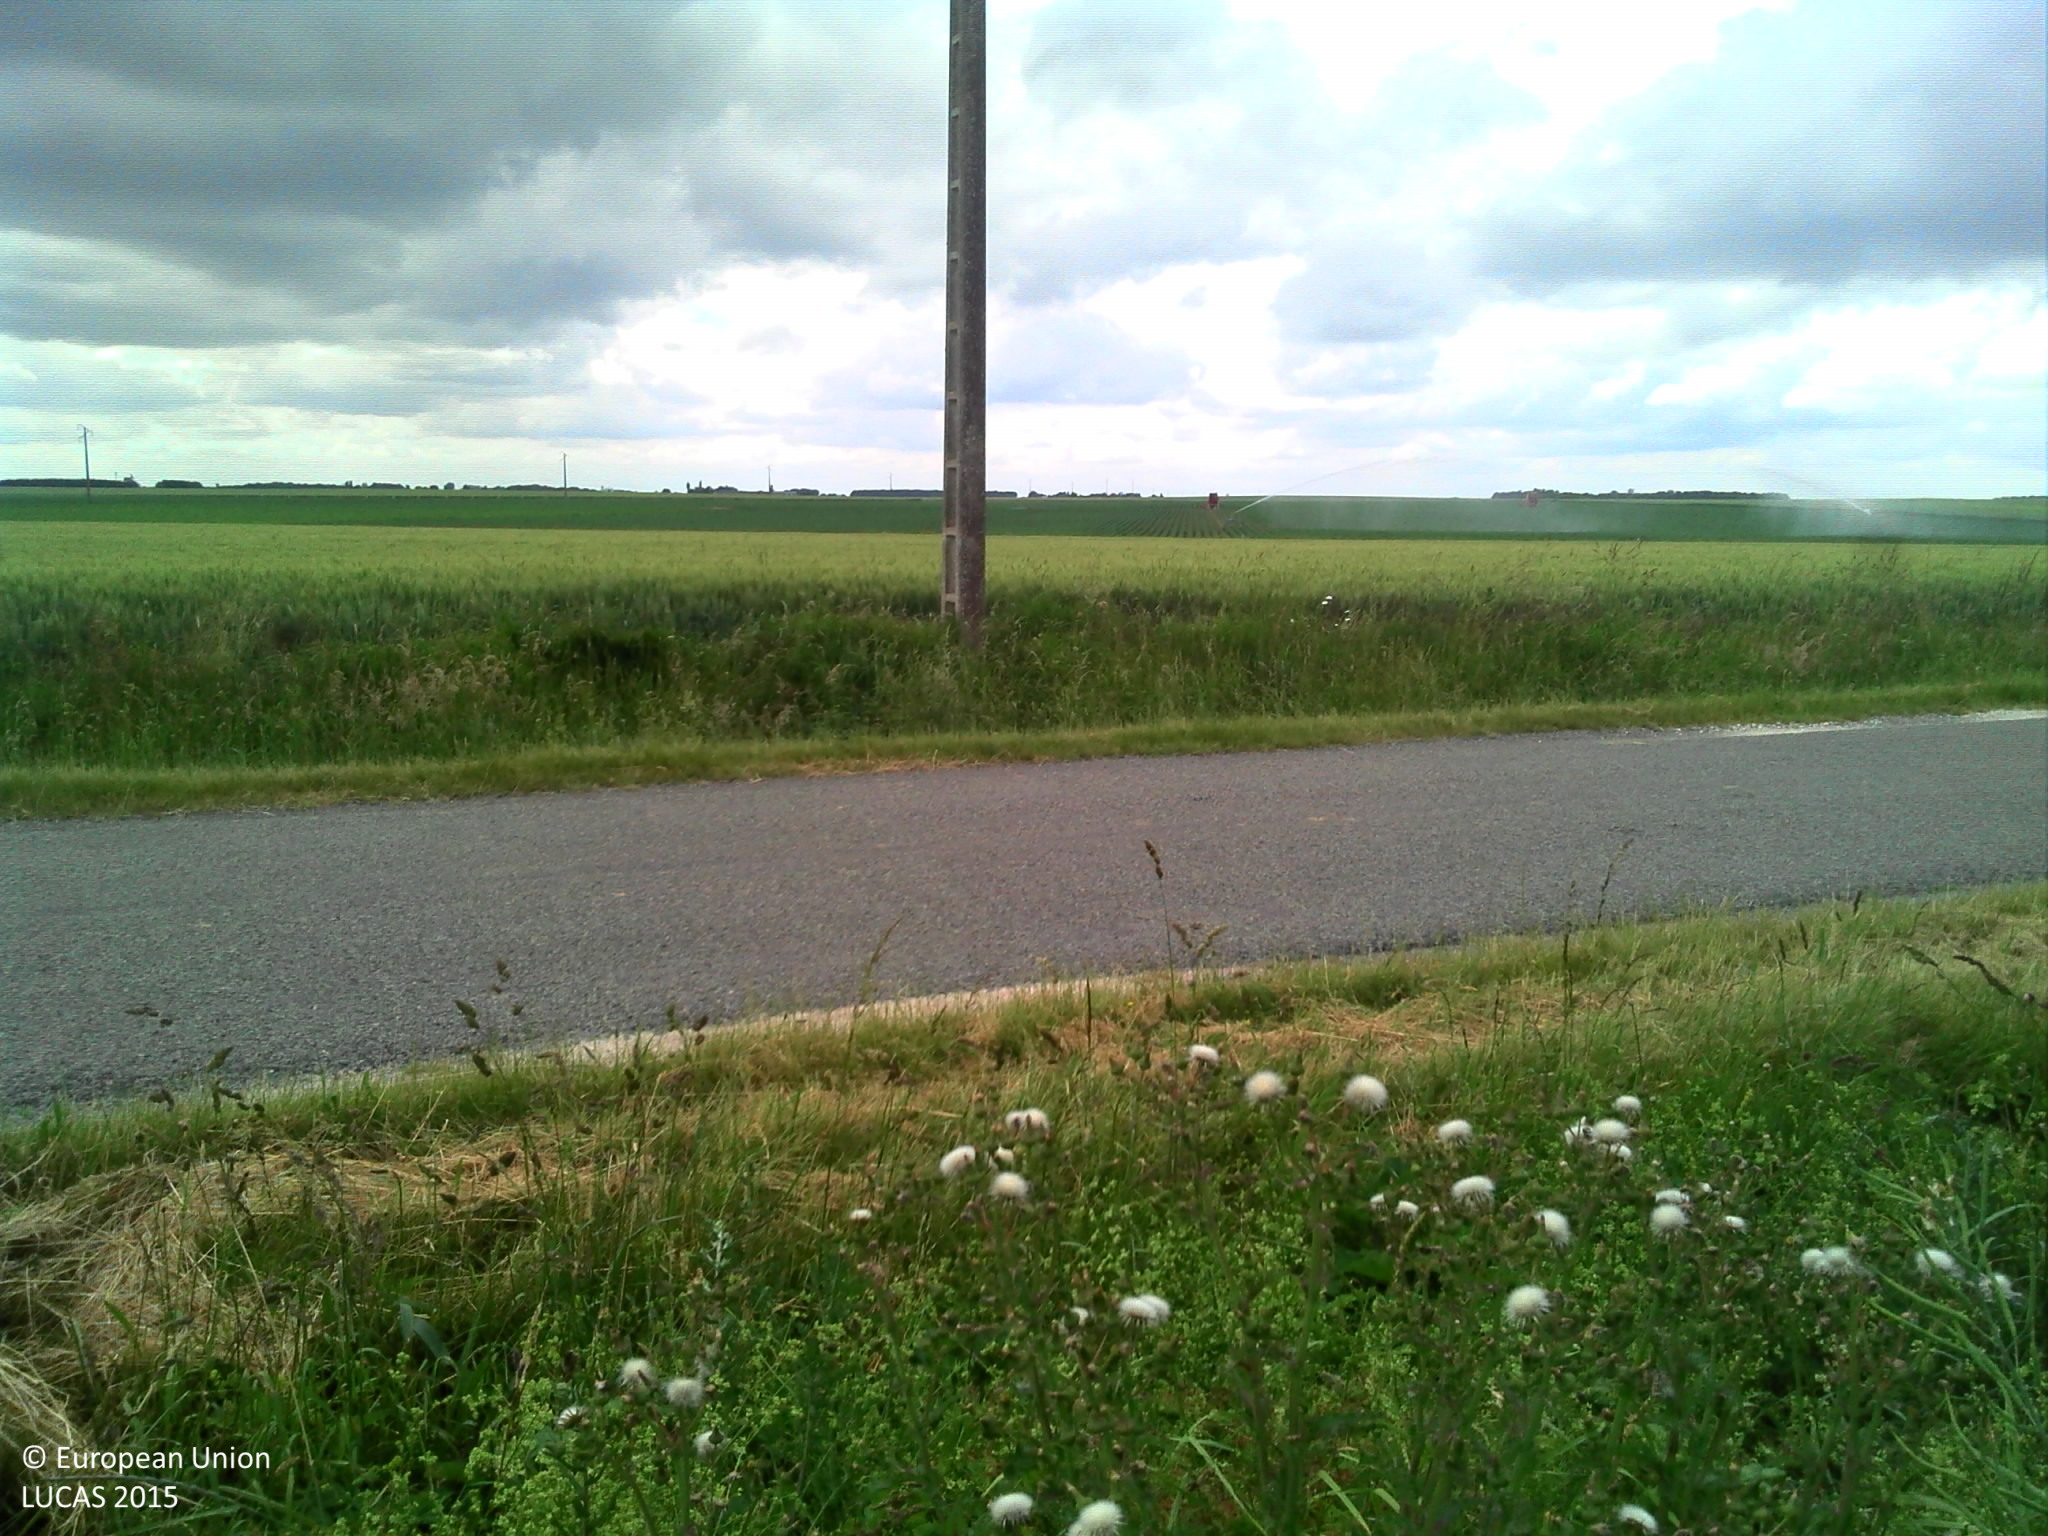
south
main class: Cropland
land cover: Rape and turnip rape
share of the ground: > 75 %
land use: Agriculture (excluding fallow land and kitchen gardens)
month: June
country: FR
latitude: 48.3248
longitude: 1.4457
